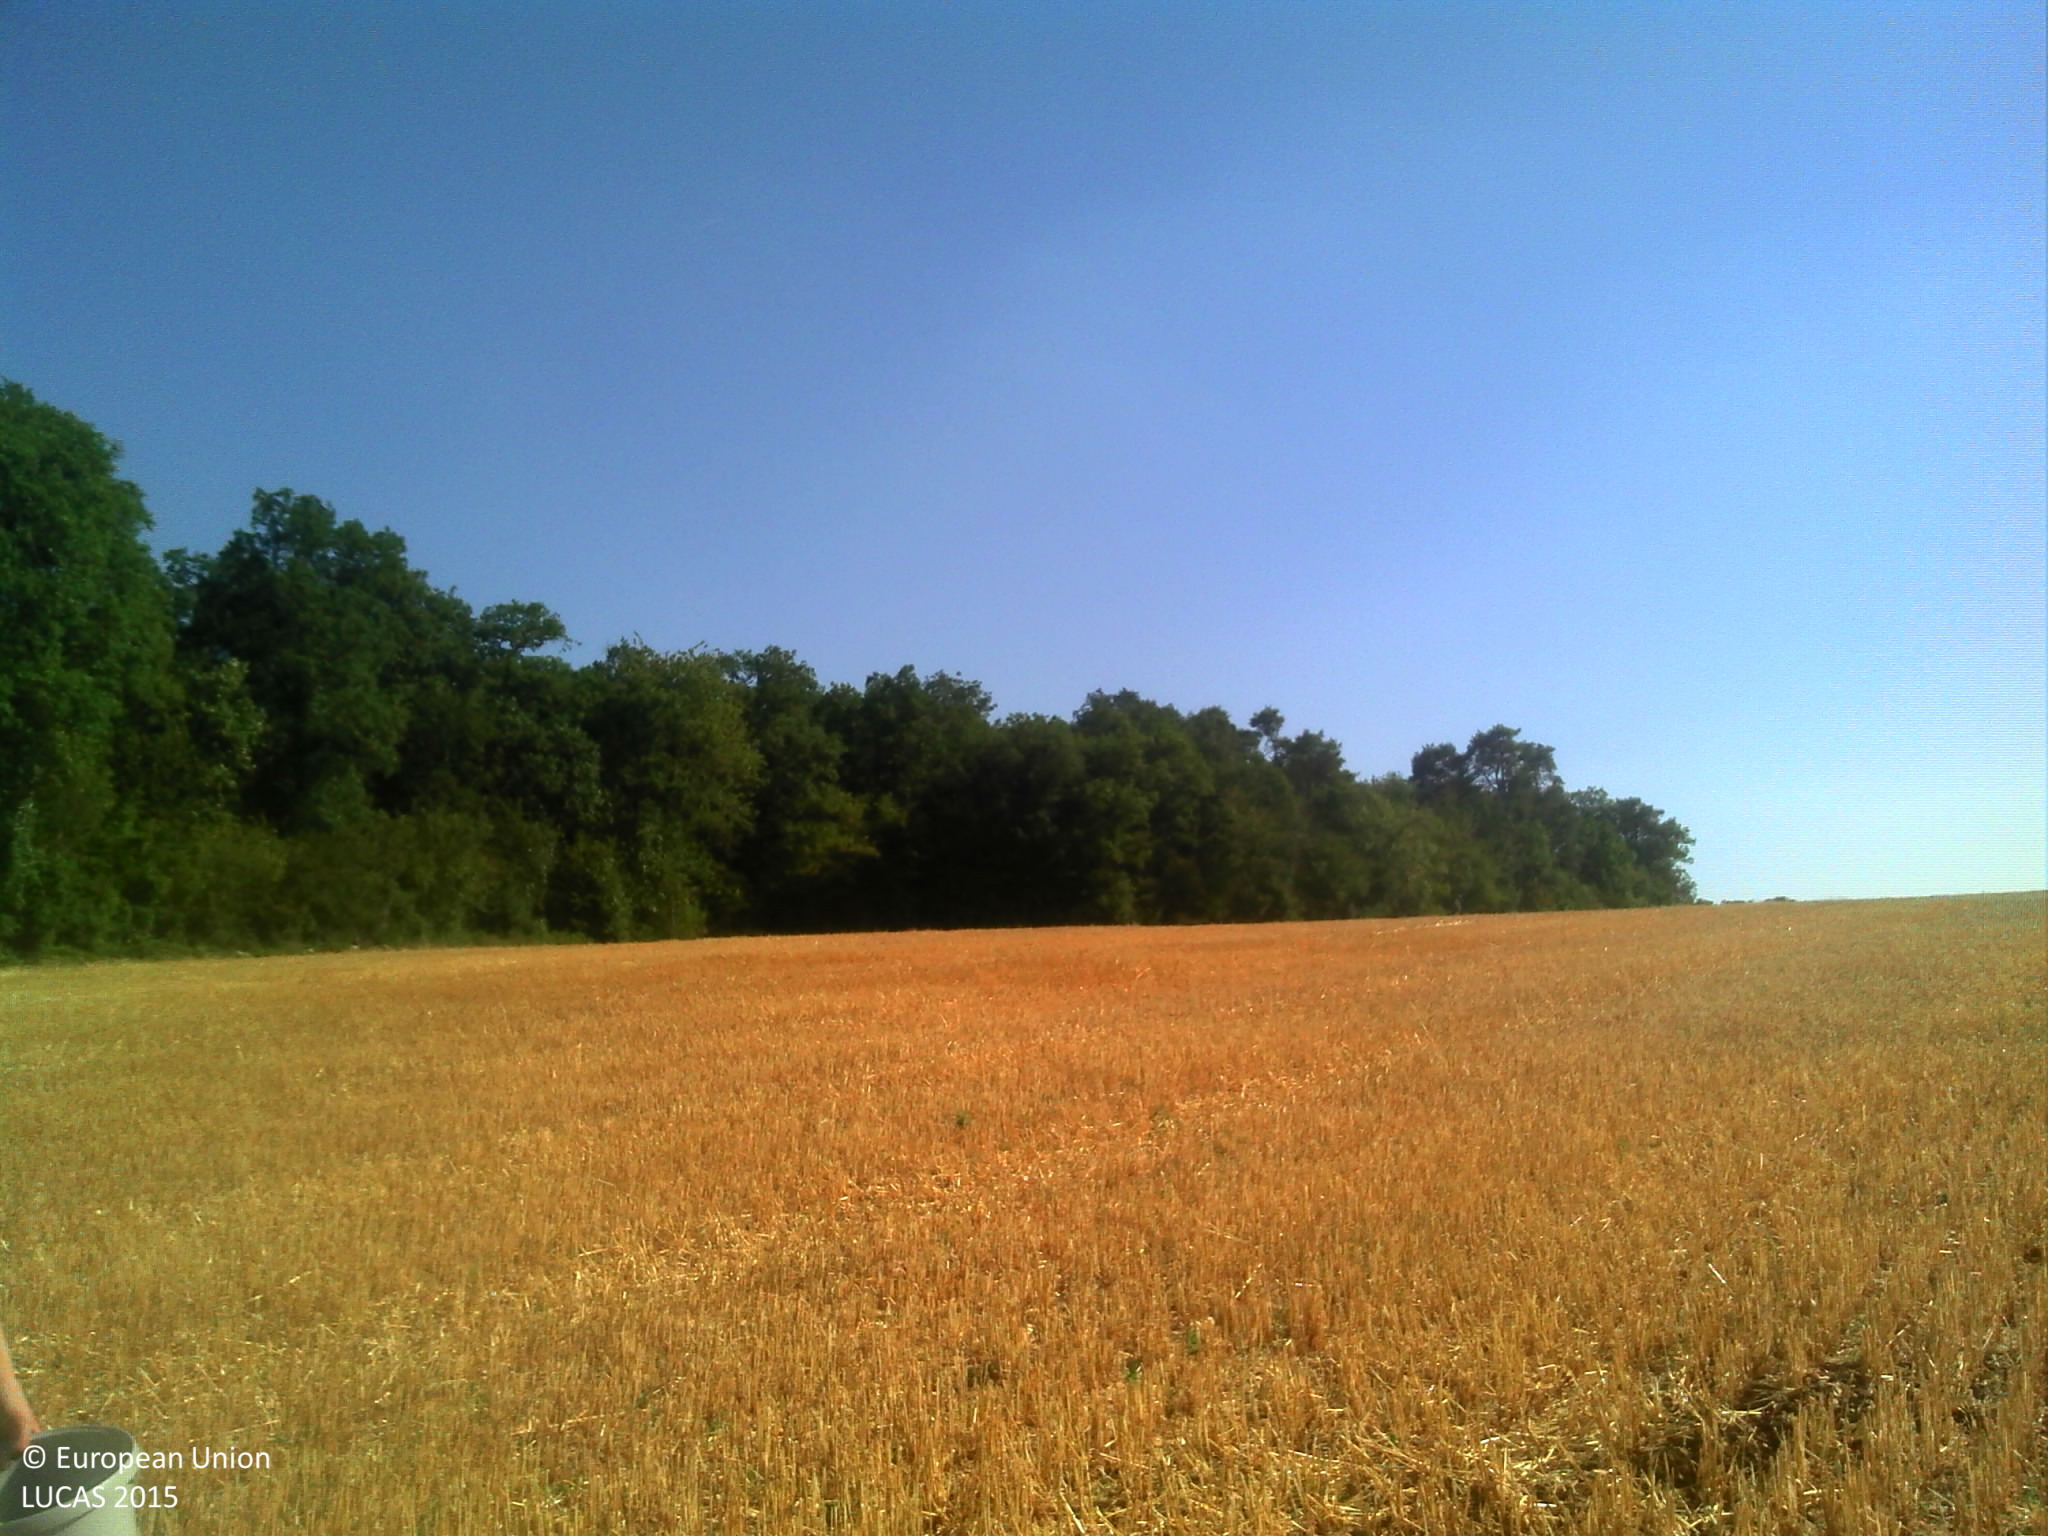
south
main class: Cropland
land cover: Barley
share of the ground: < 10 %
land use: Agriculture (excluding fallow land and kitchen gardens)
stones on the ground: 10 - 25 %
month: August
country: FR
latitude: 47.7159
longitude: 5.0544
